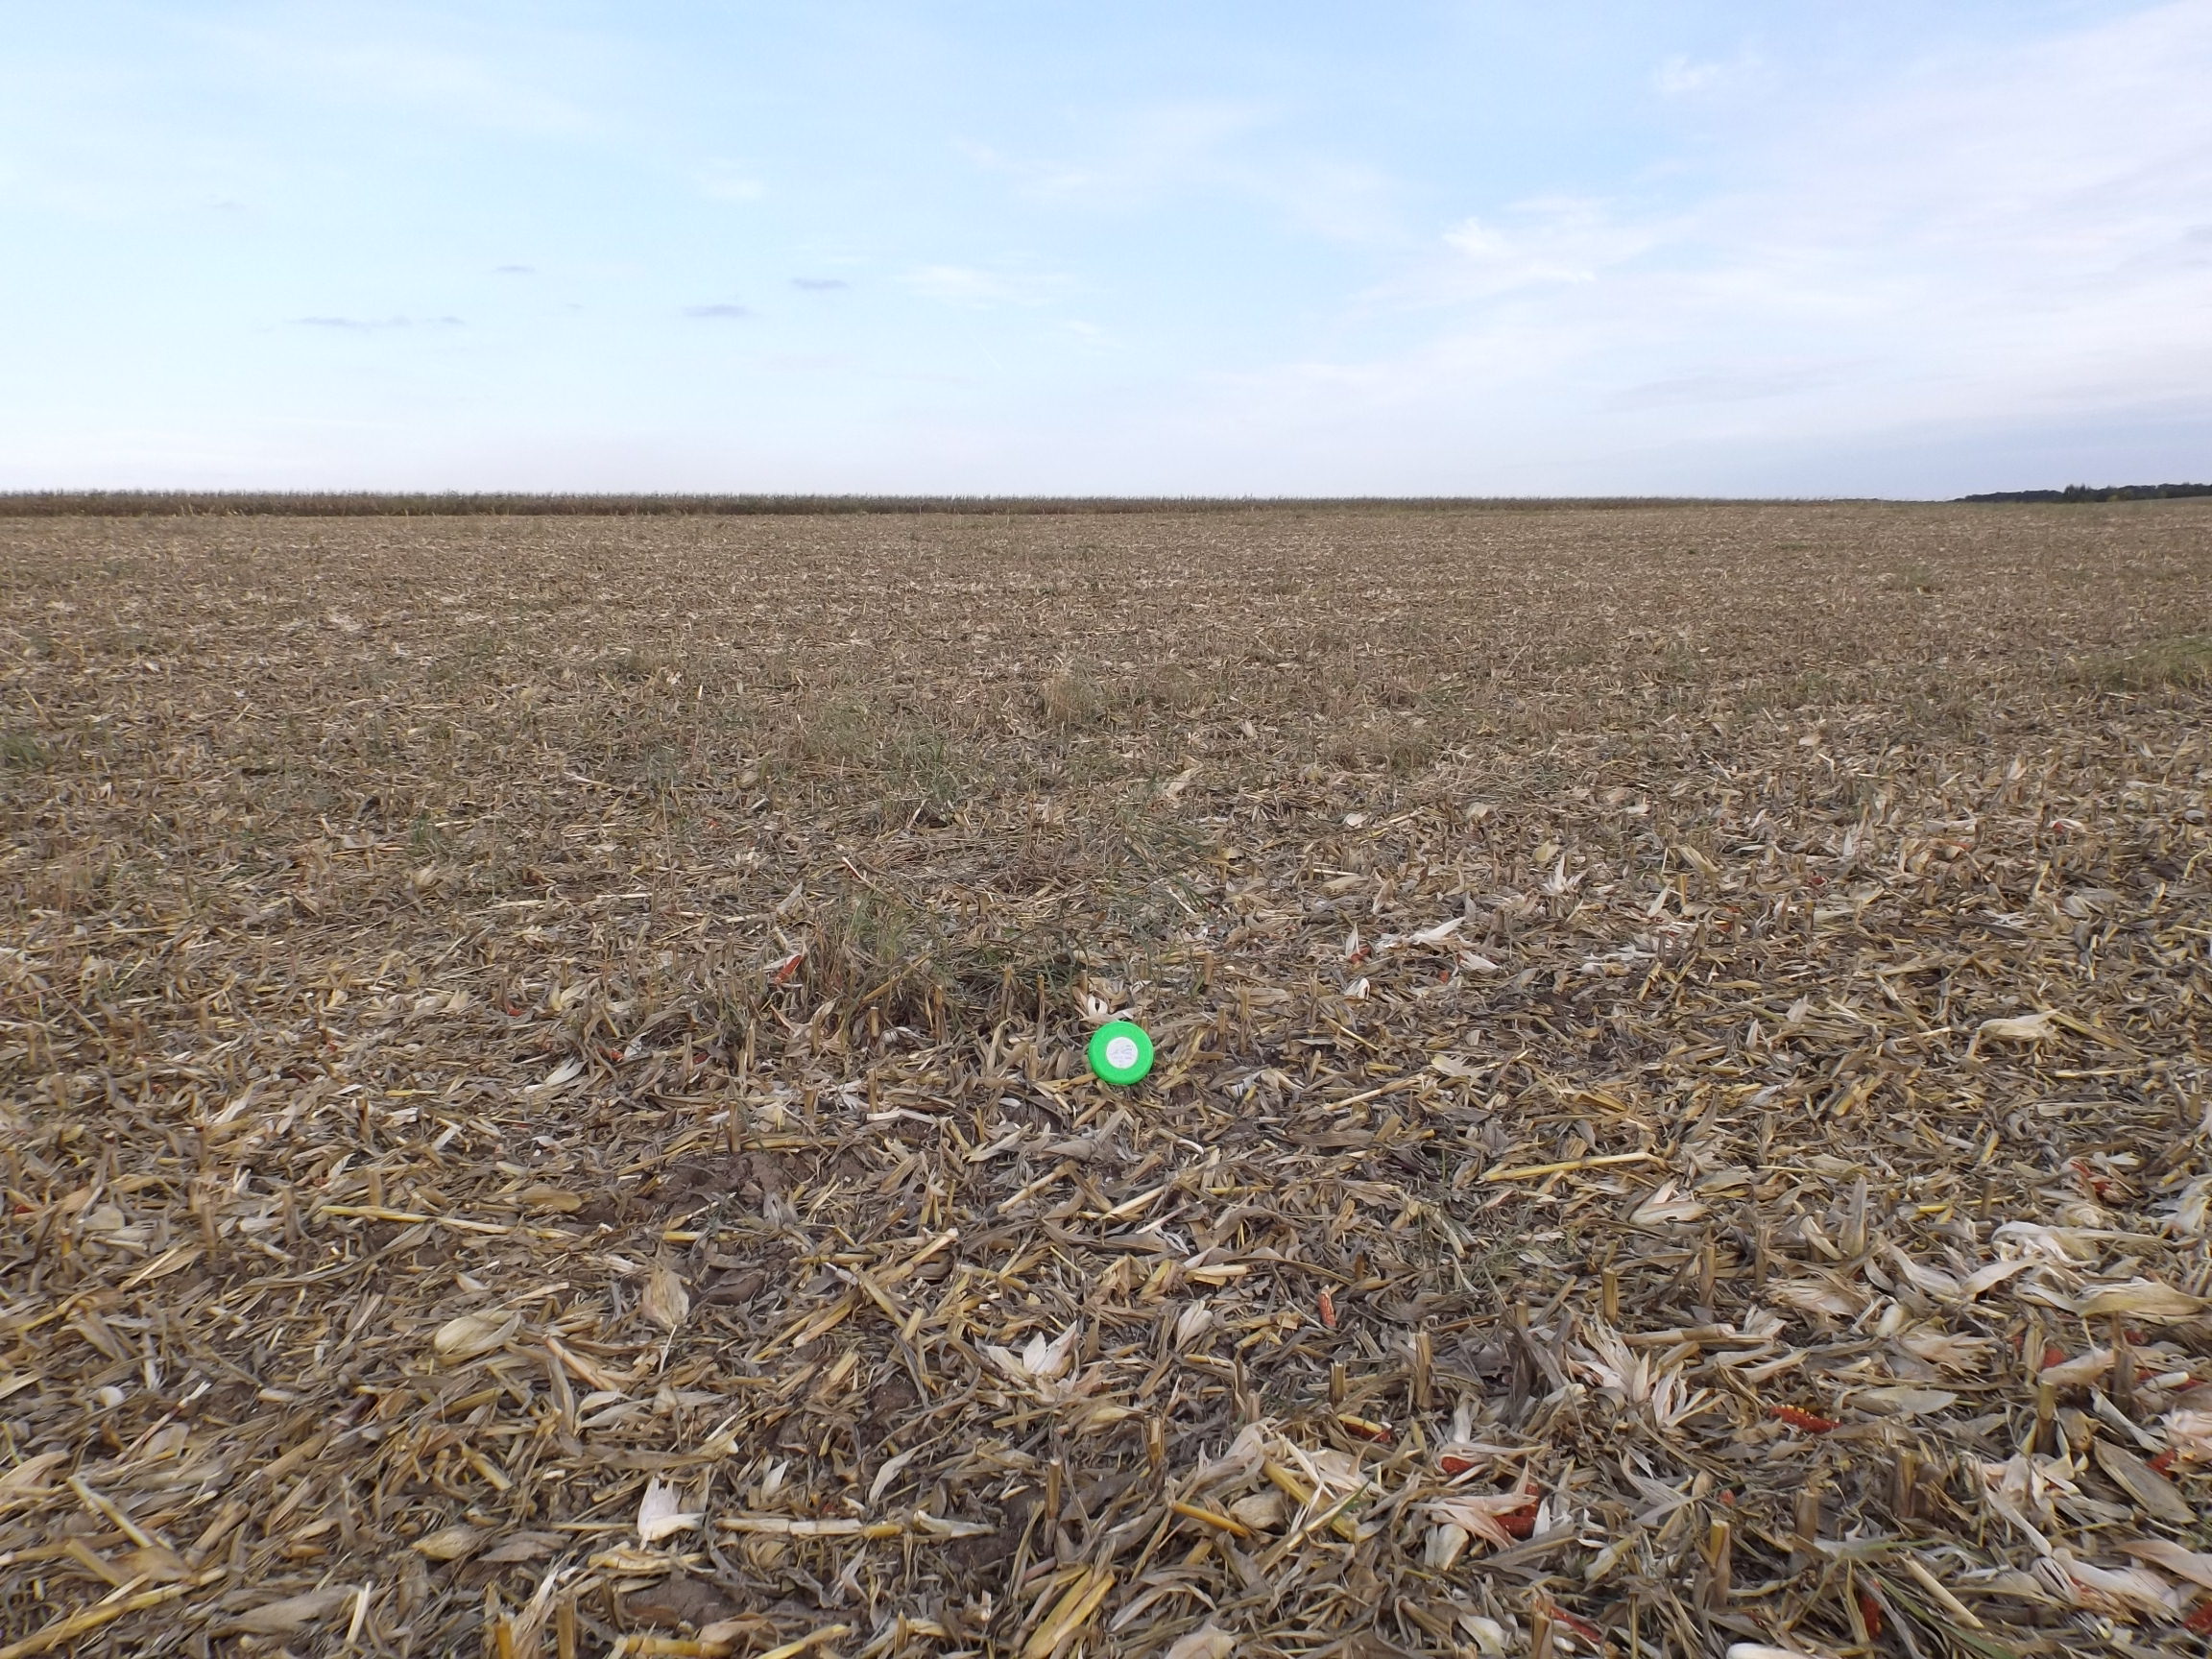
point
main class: Cropland
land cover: Maize
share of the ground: 50 - 75 %
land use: Agriculture (excluding fallow land and kitchen gardens)
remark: Harvested field
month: October
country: BG
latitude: 43.9572
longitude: 26.8297
